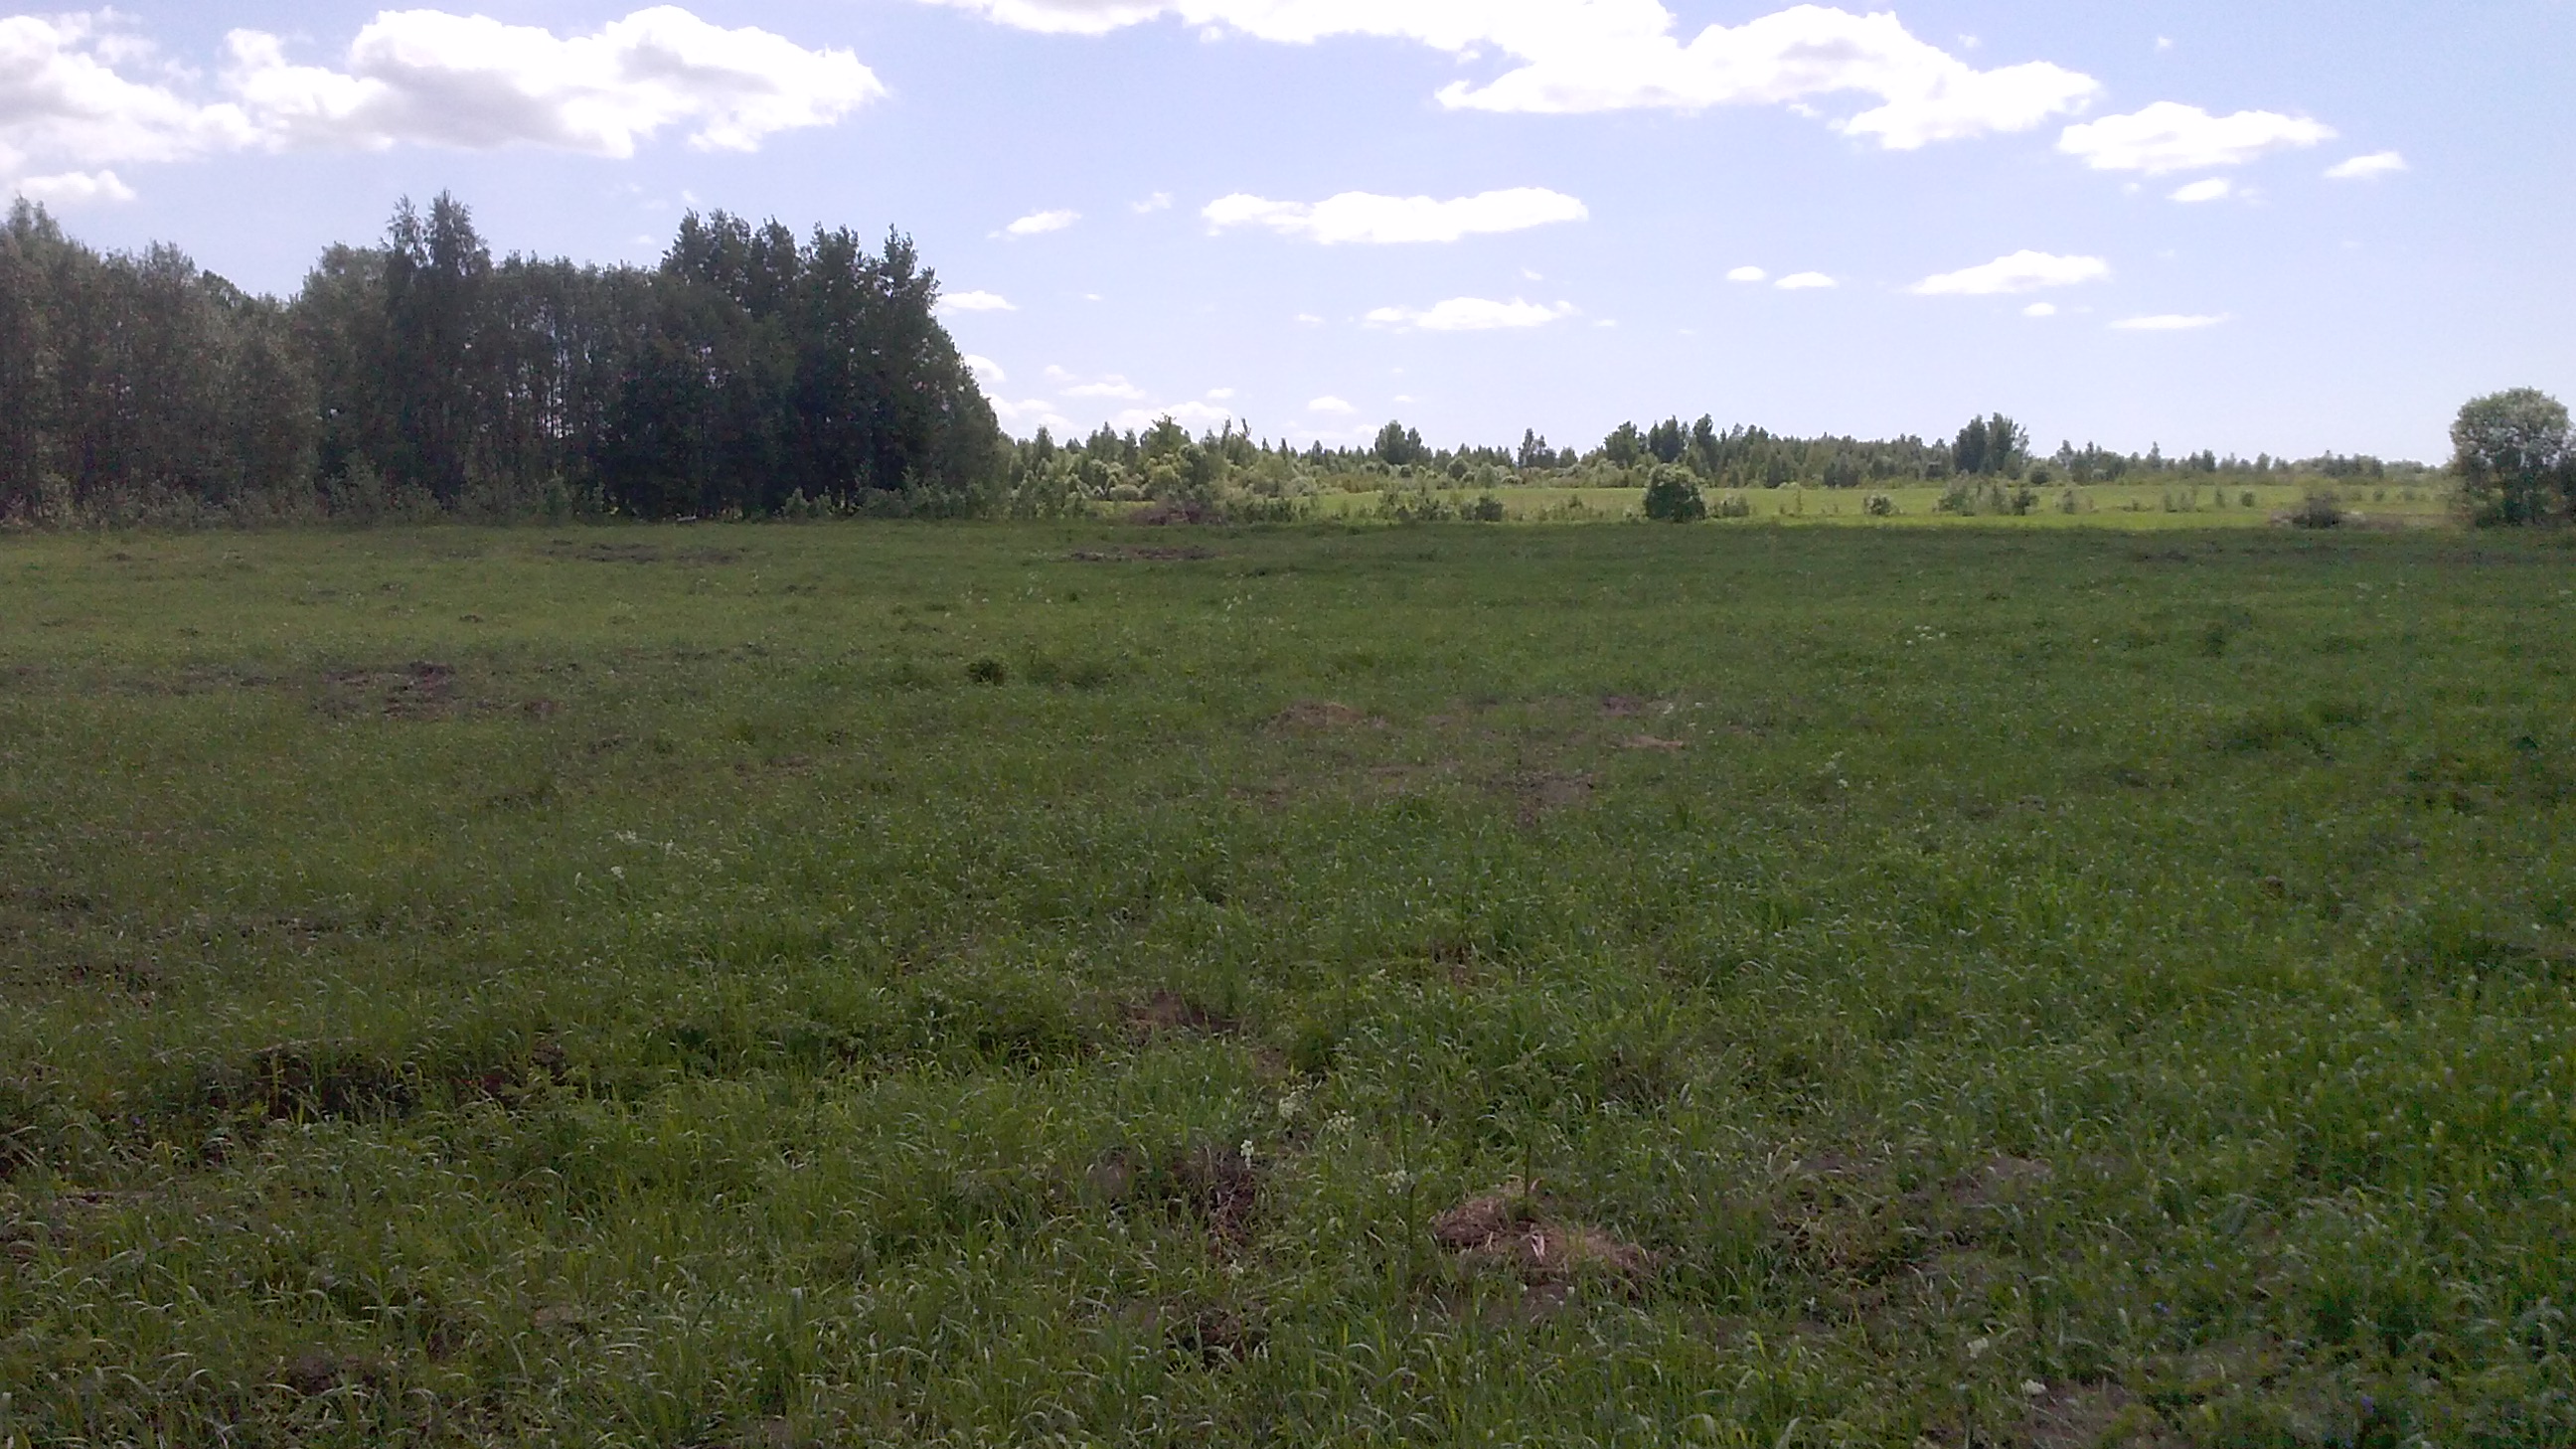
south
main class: Grassland
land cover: Grassland without tree/shrub cover
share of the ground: > 75 %
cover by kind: herbaceous plants 75 %, unconsolidated bare surface 25 %
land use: Agriculture (excluding fallow land and kitchen gardens)
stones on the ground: < 10 %
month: May
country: LV
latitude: 56.3267
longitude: 27.1655
